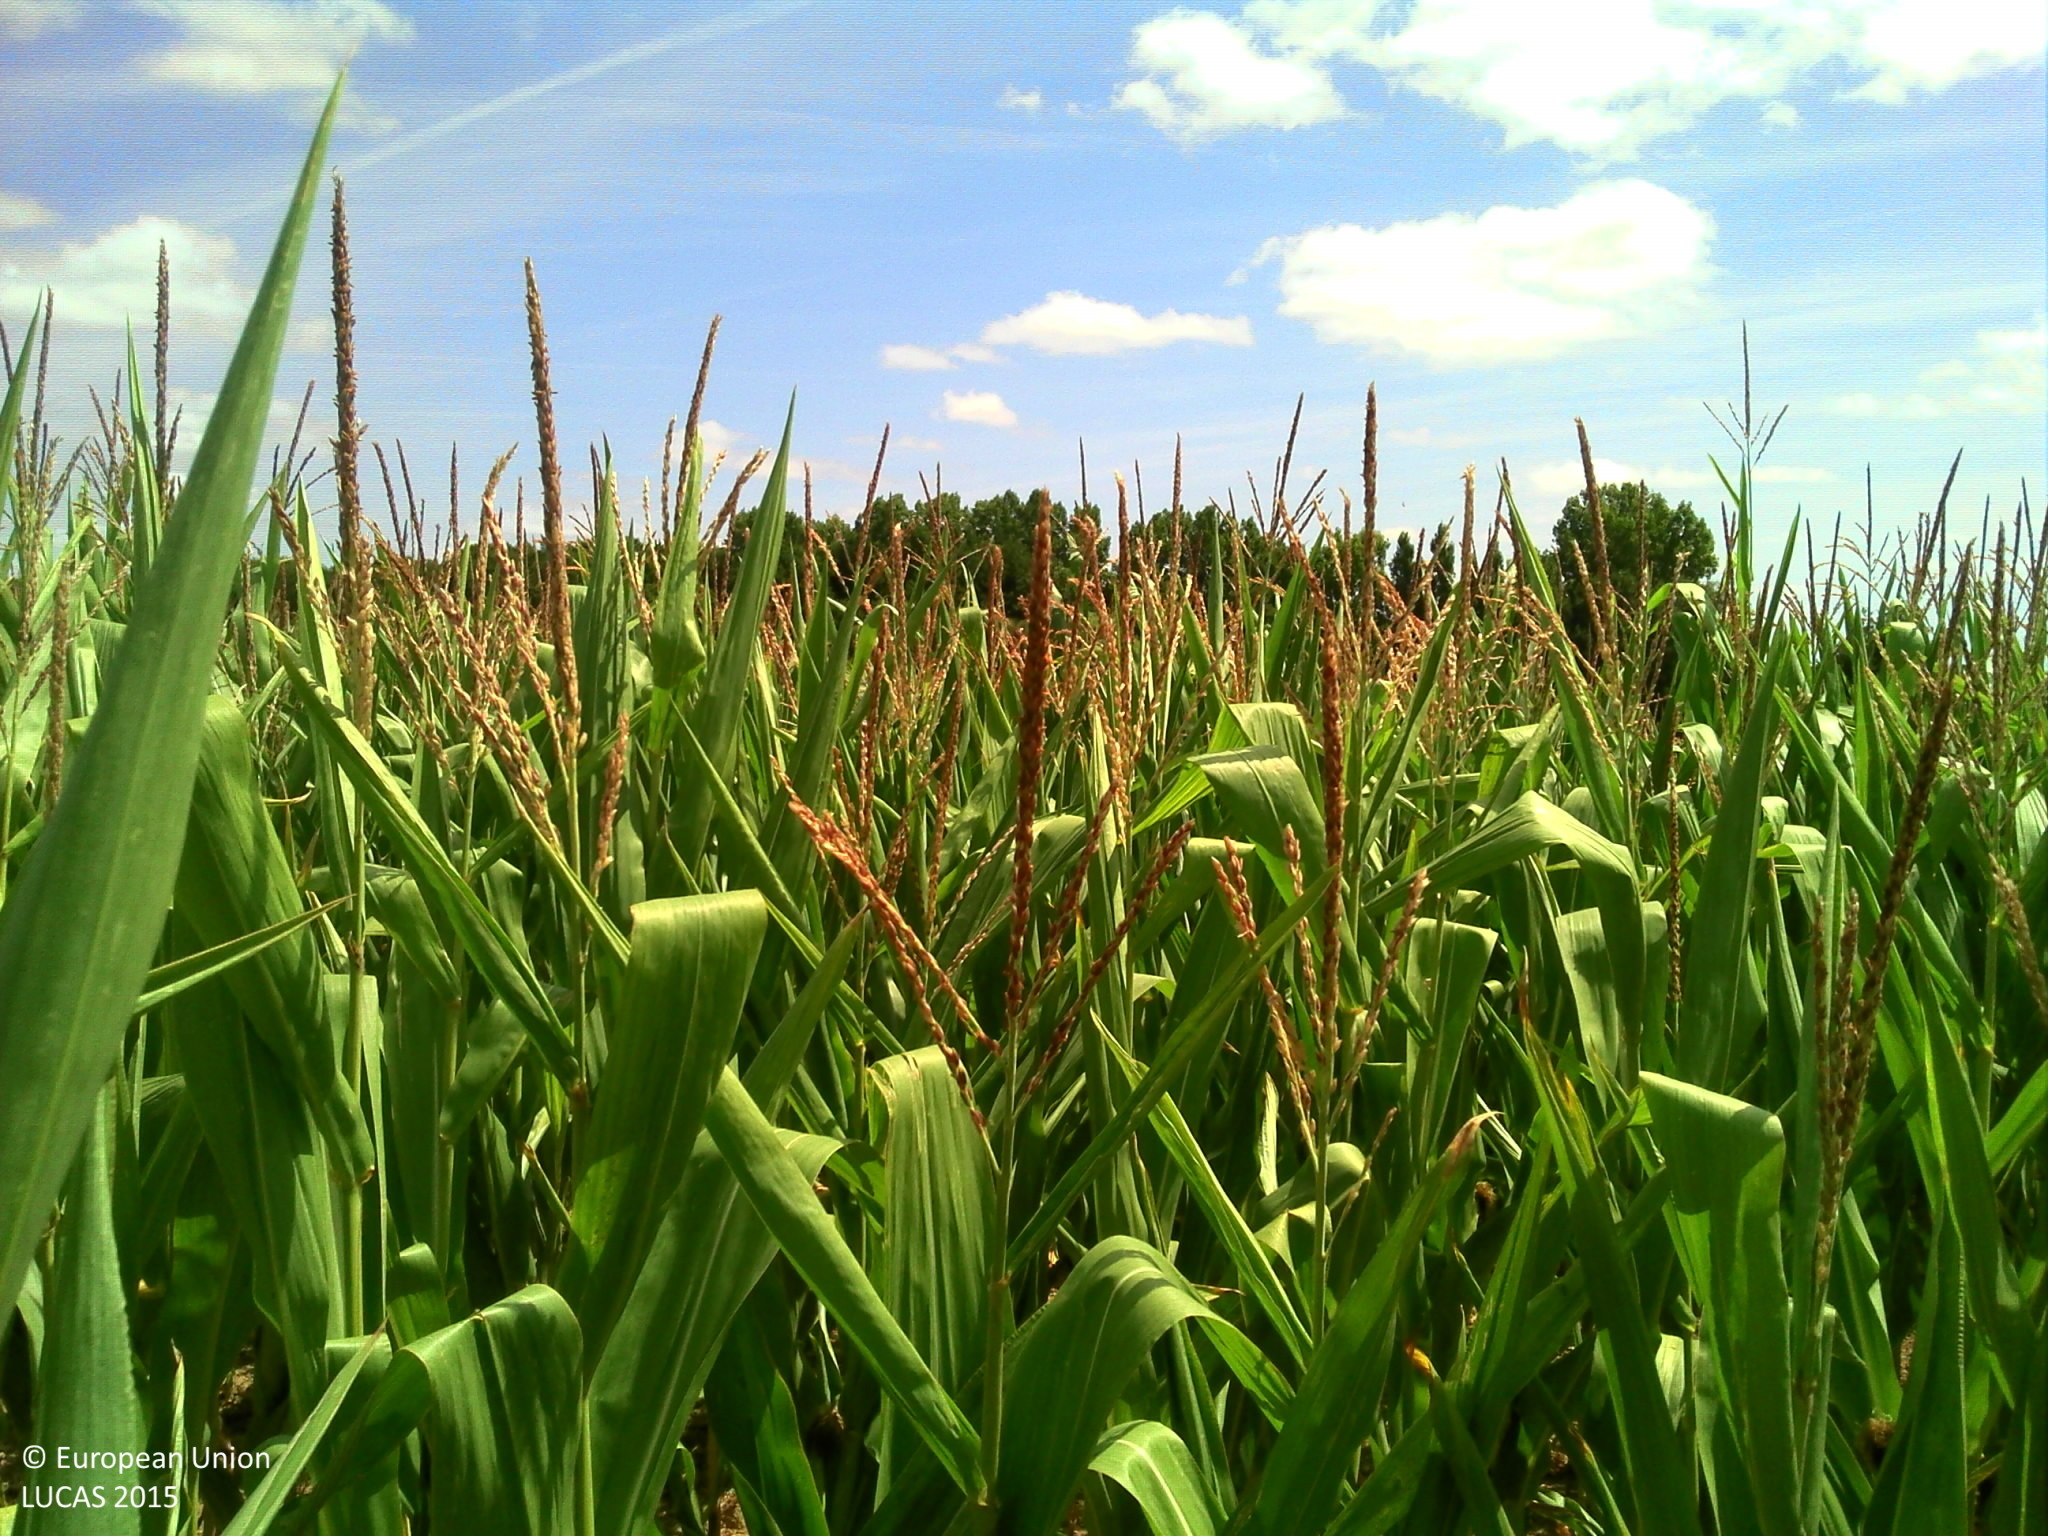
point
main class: Cropland
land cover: Maize
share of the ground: > 75 %
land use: Agriculture (excluding fallow land and kitchen gardens)
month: August
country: FR
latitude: 47.8206
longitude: -1.1390
